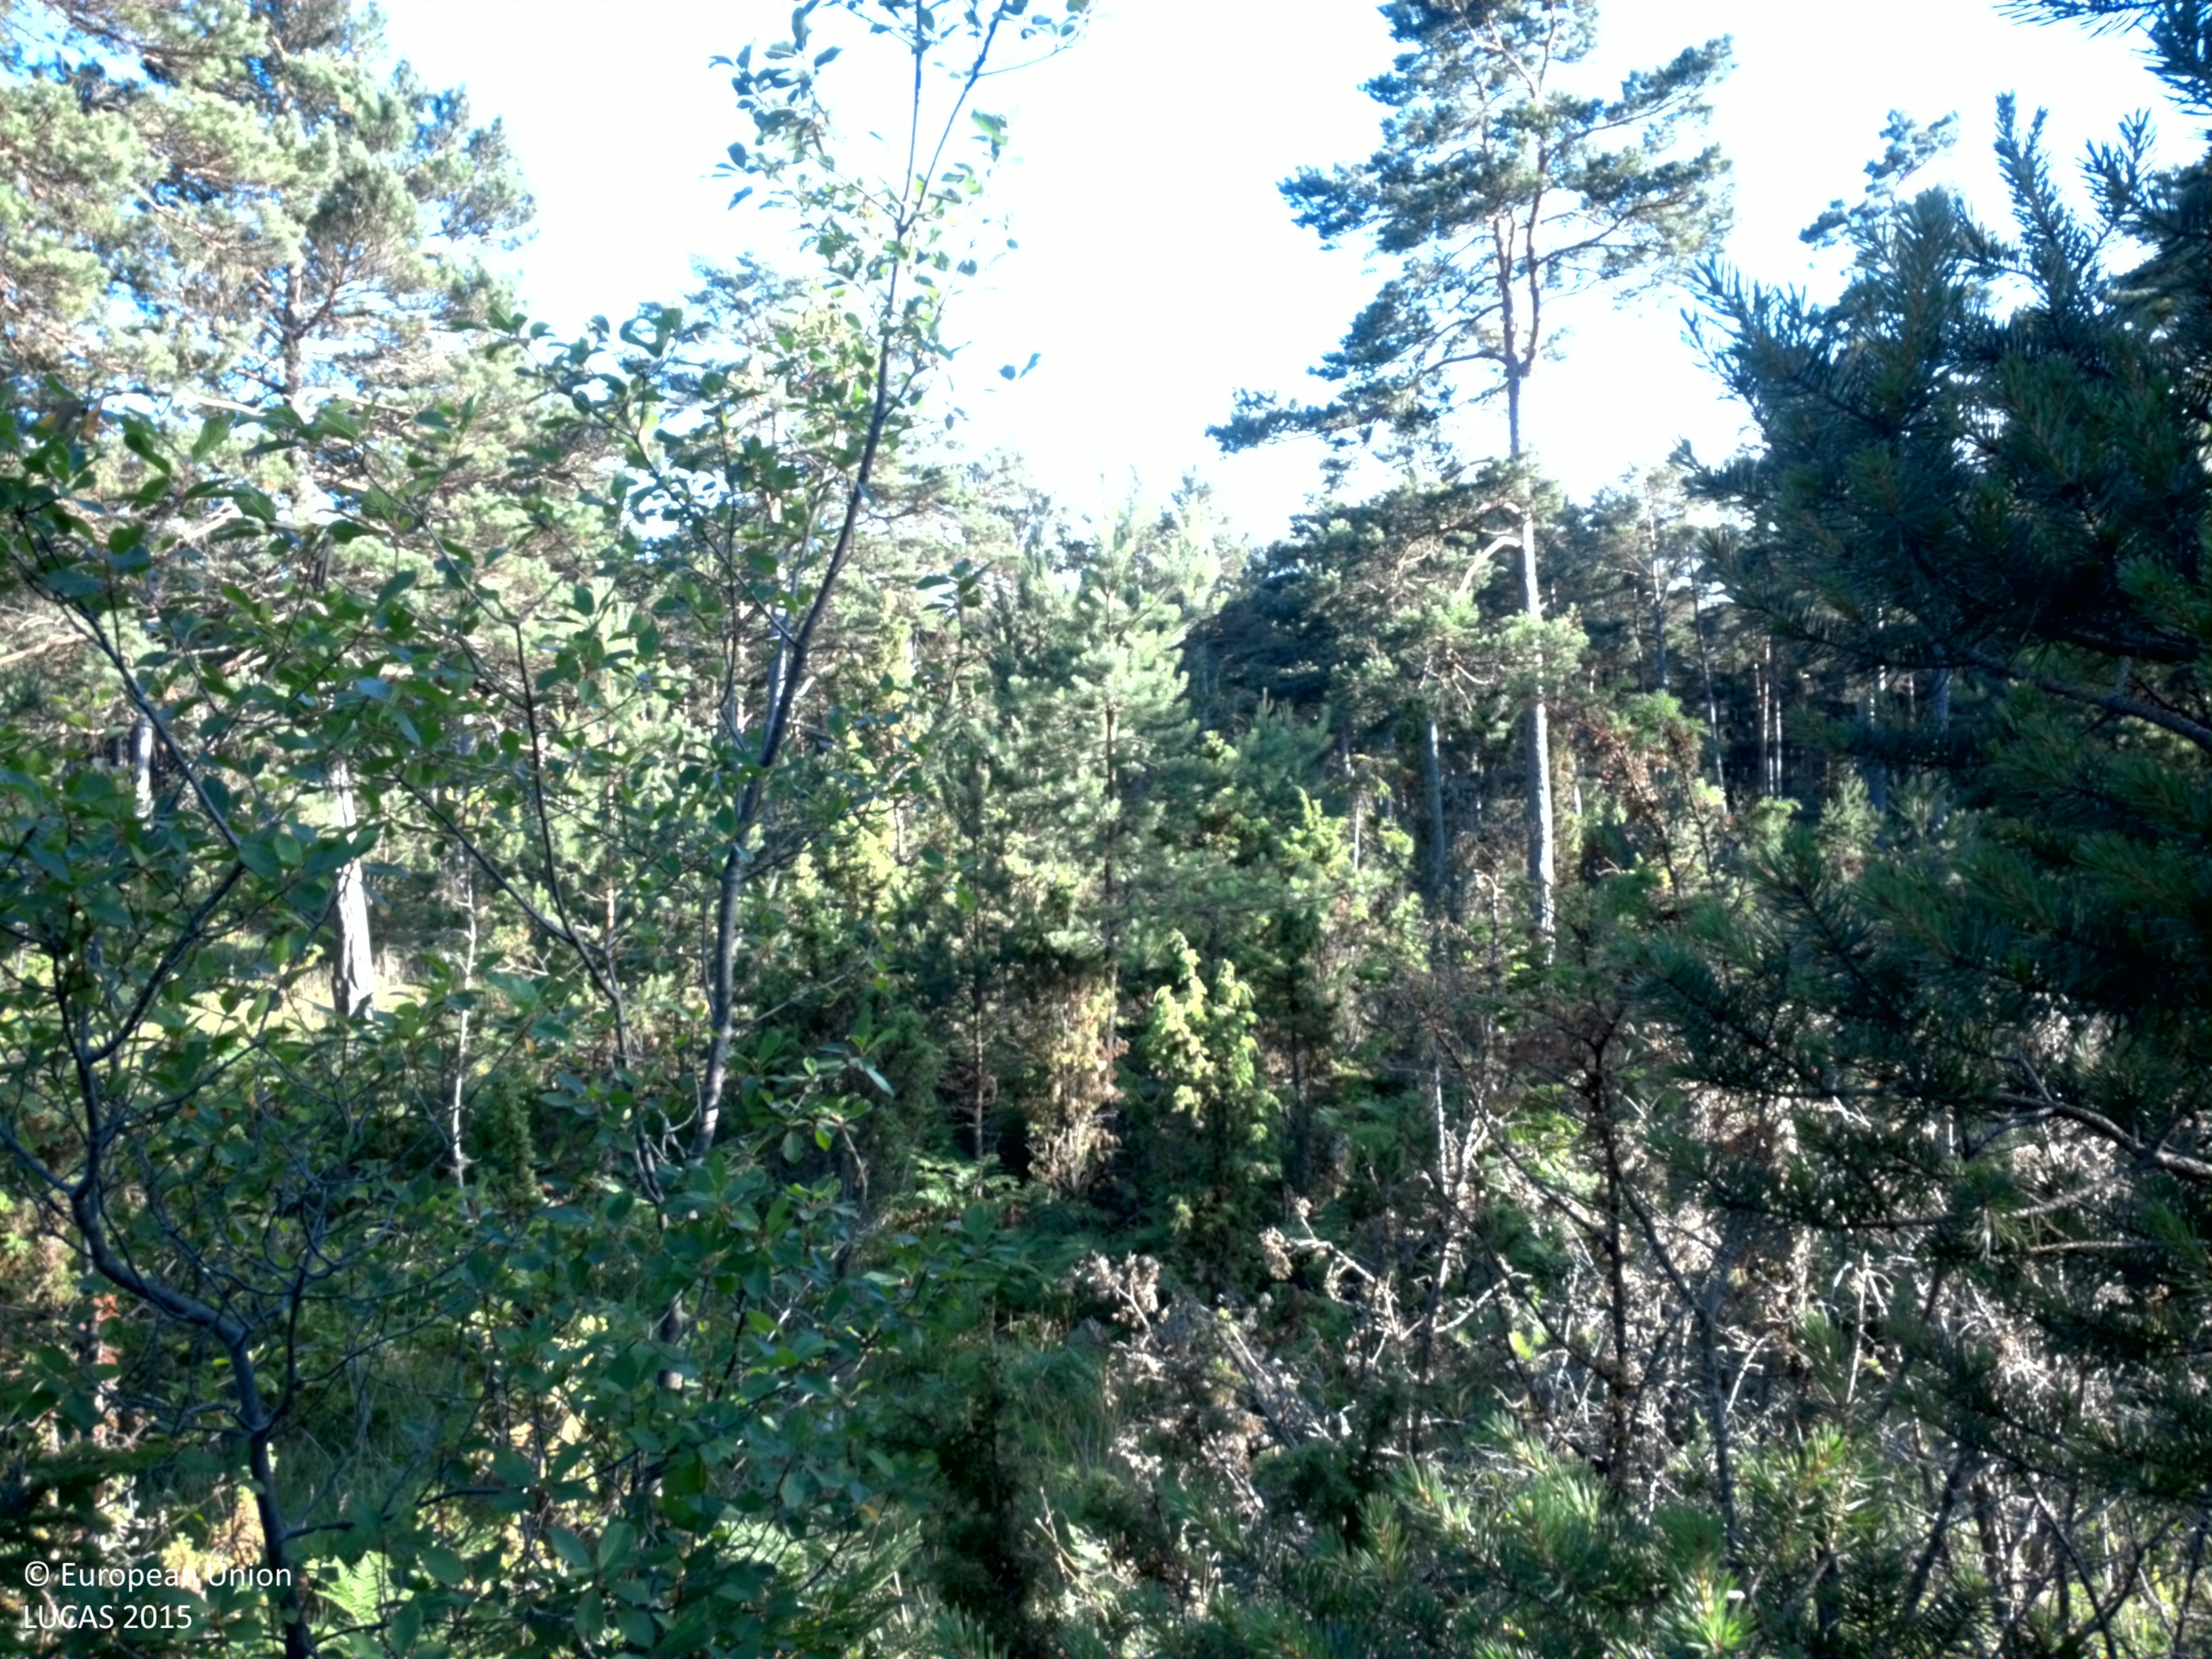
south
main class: Woodland
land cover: Pine dominated coniferous woodland
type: hemiboreal forest and nemoral coniferous forest and mixed broadleaved-coniferous forest
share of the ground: 50 - 75 %
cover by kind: coniferous forest trees 65 %, herbaceous plants 20 %, shrubs 15 %
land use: Forestry
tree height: > 5 m
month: July
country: SE
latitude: 57.6049
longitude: 18.7963
